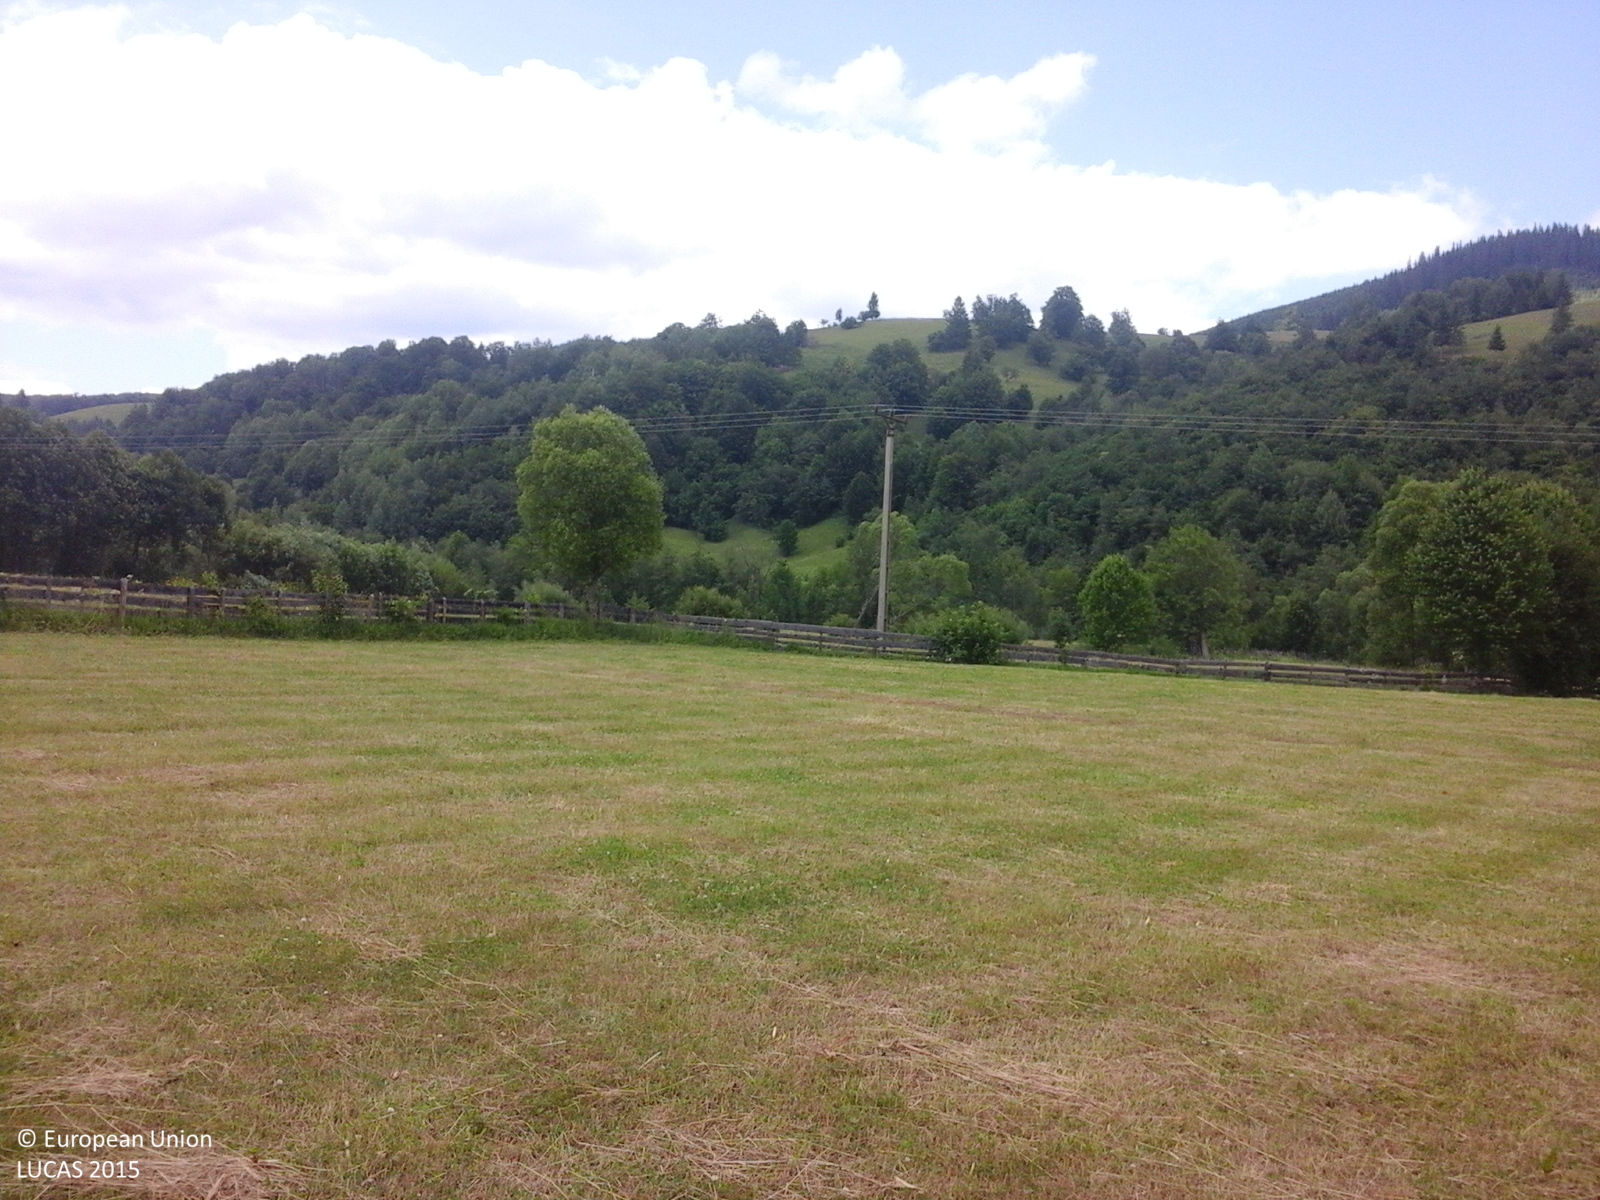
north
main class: Grassland
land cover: Grassland without tree/shrub cover
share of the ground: > 75 %
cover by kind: herbaceous plants 100 %
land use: Agriculture (excluding fallow land and kitchen gardens)
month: June
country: RO
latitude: 47.6228
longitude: 25.8127
